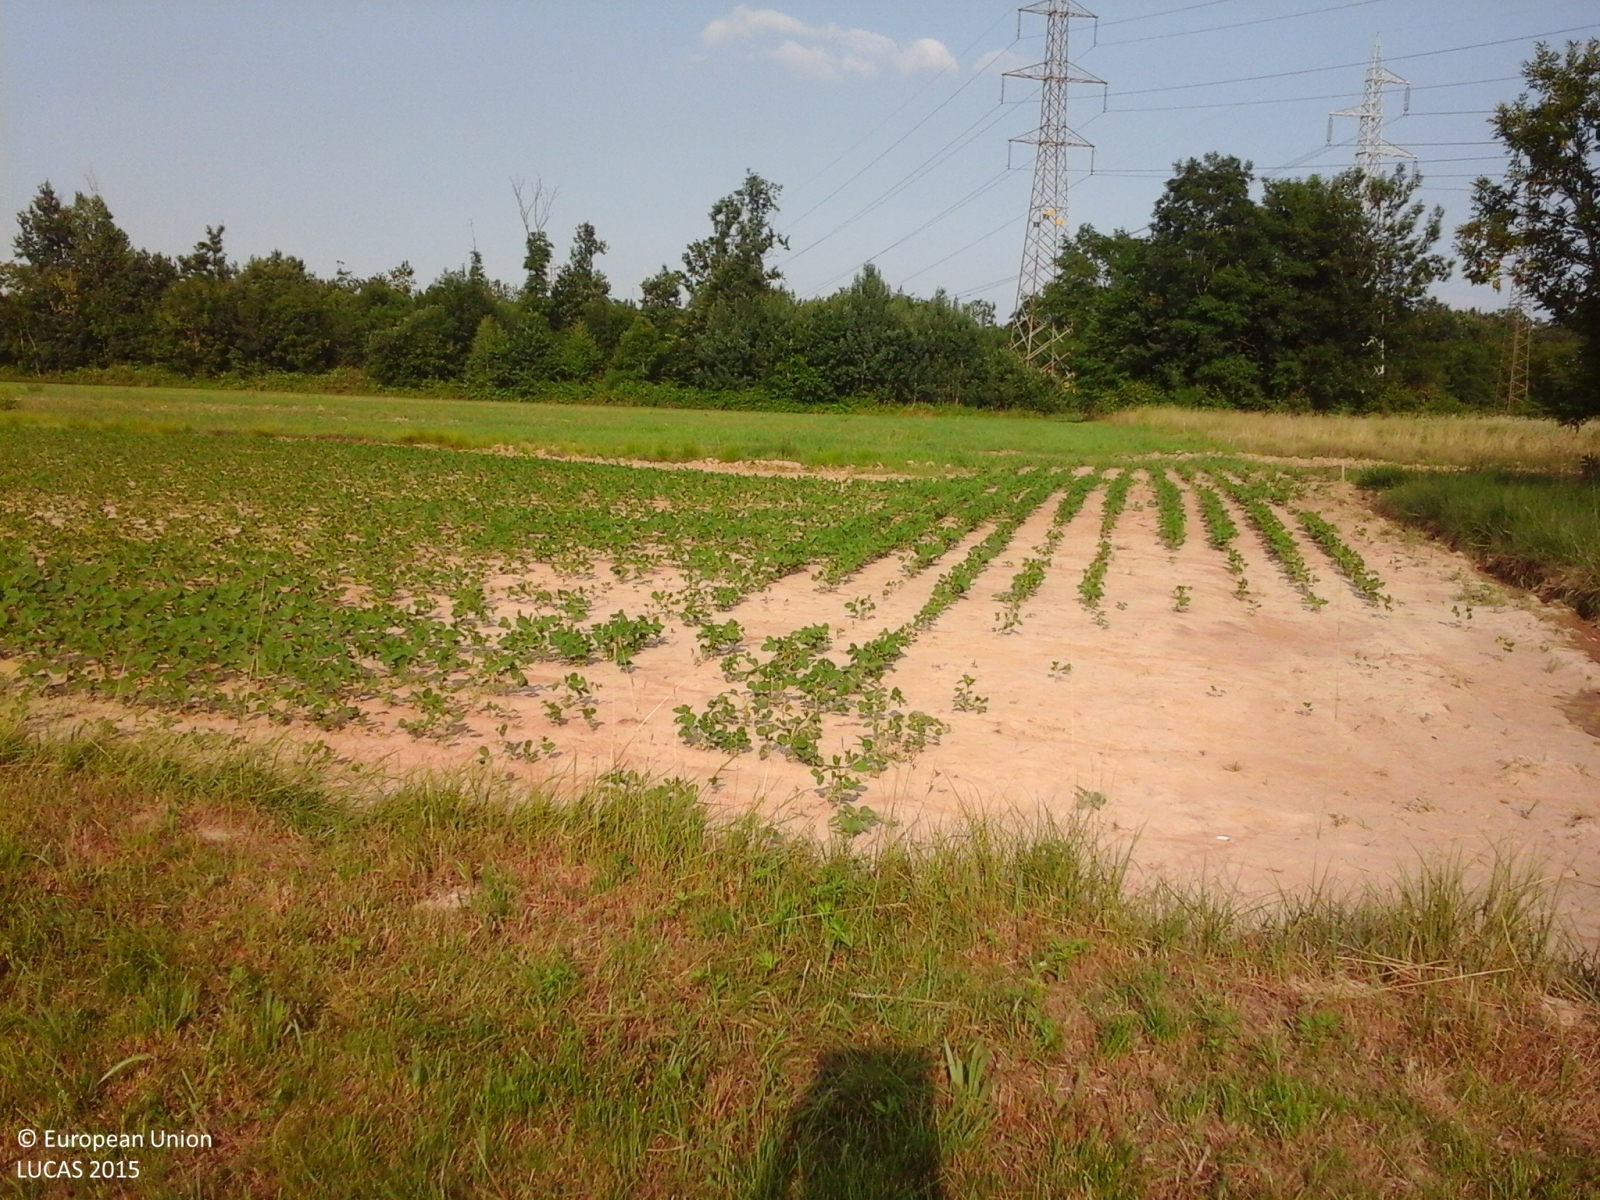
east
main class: Grassland
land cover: Grassland without tree/shrub cover
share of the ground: > 75 %
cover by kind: herbaceous plants 100 %
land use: Agriculture (excluding fallow land and kitchen gardens)
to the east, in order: Grassland without tree/shrub cover; Soya; Grassland without tree/shrub cover; Broadleaved woodland; Electric lines; Broadleaved woodland; Tracks; Grassland without tree/shrub cover
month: June
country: IT
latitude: 45.2100
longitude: 7.7502
